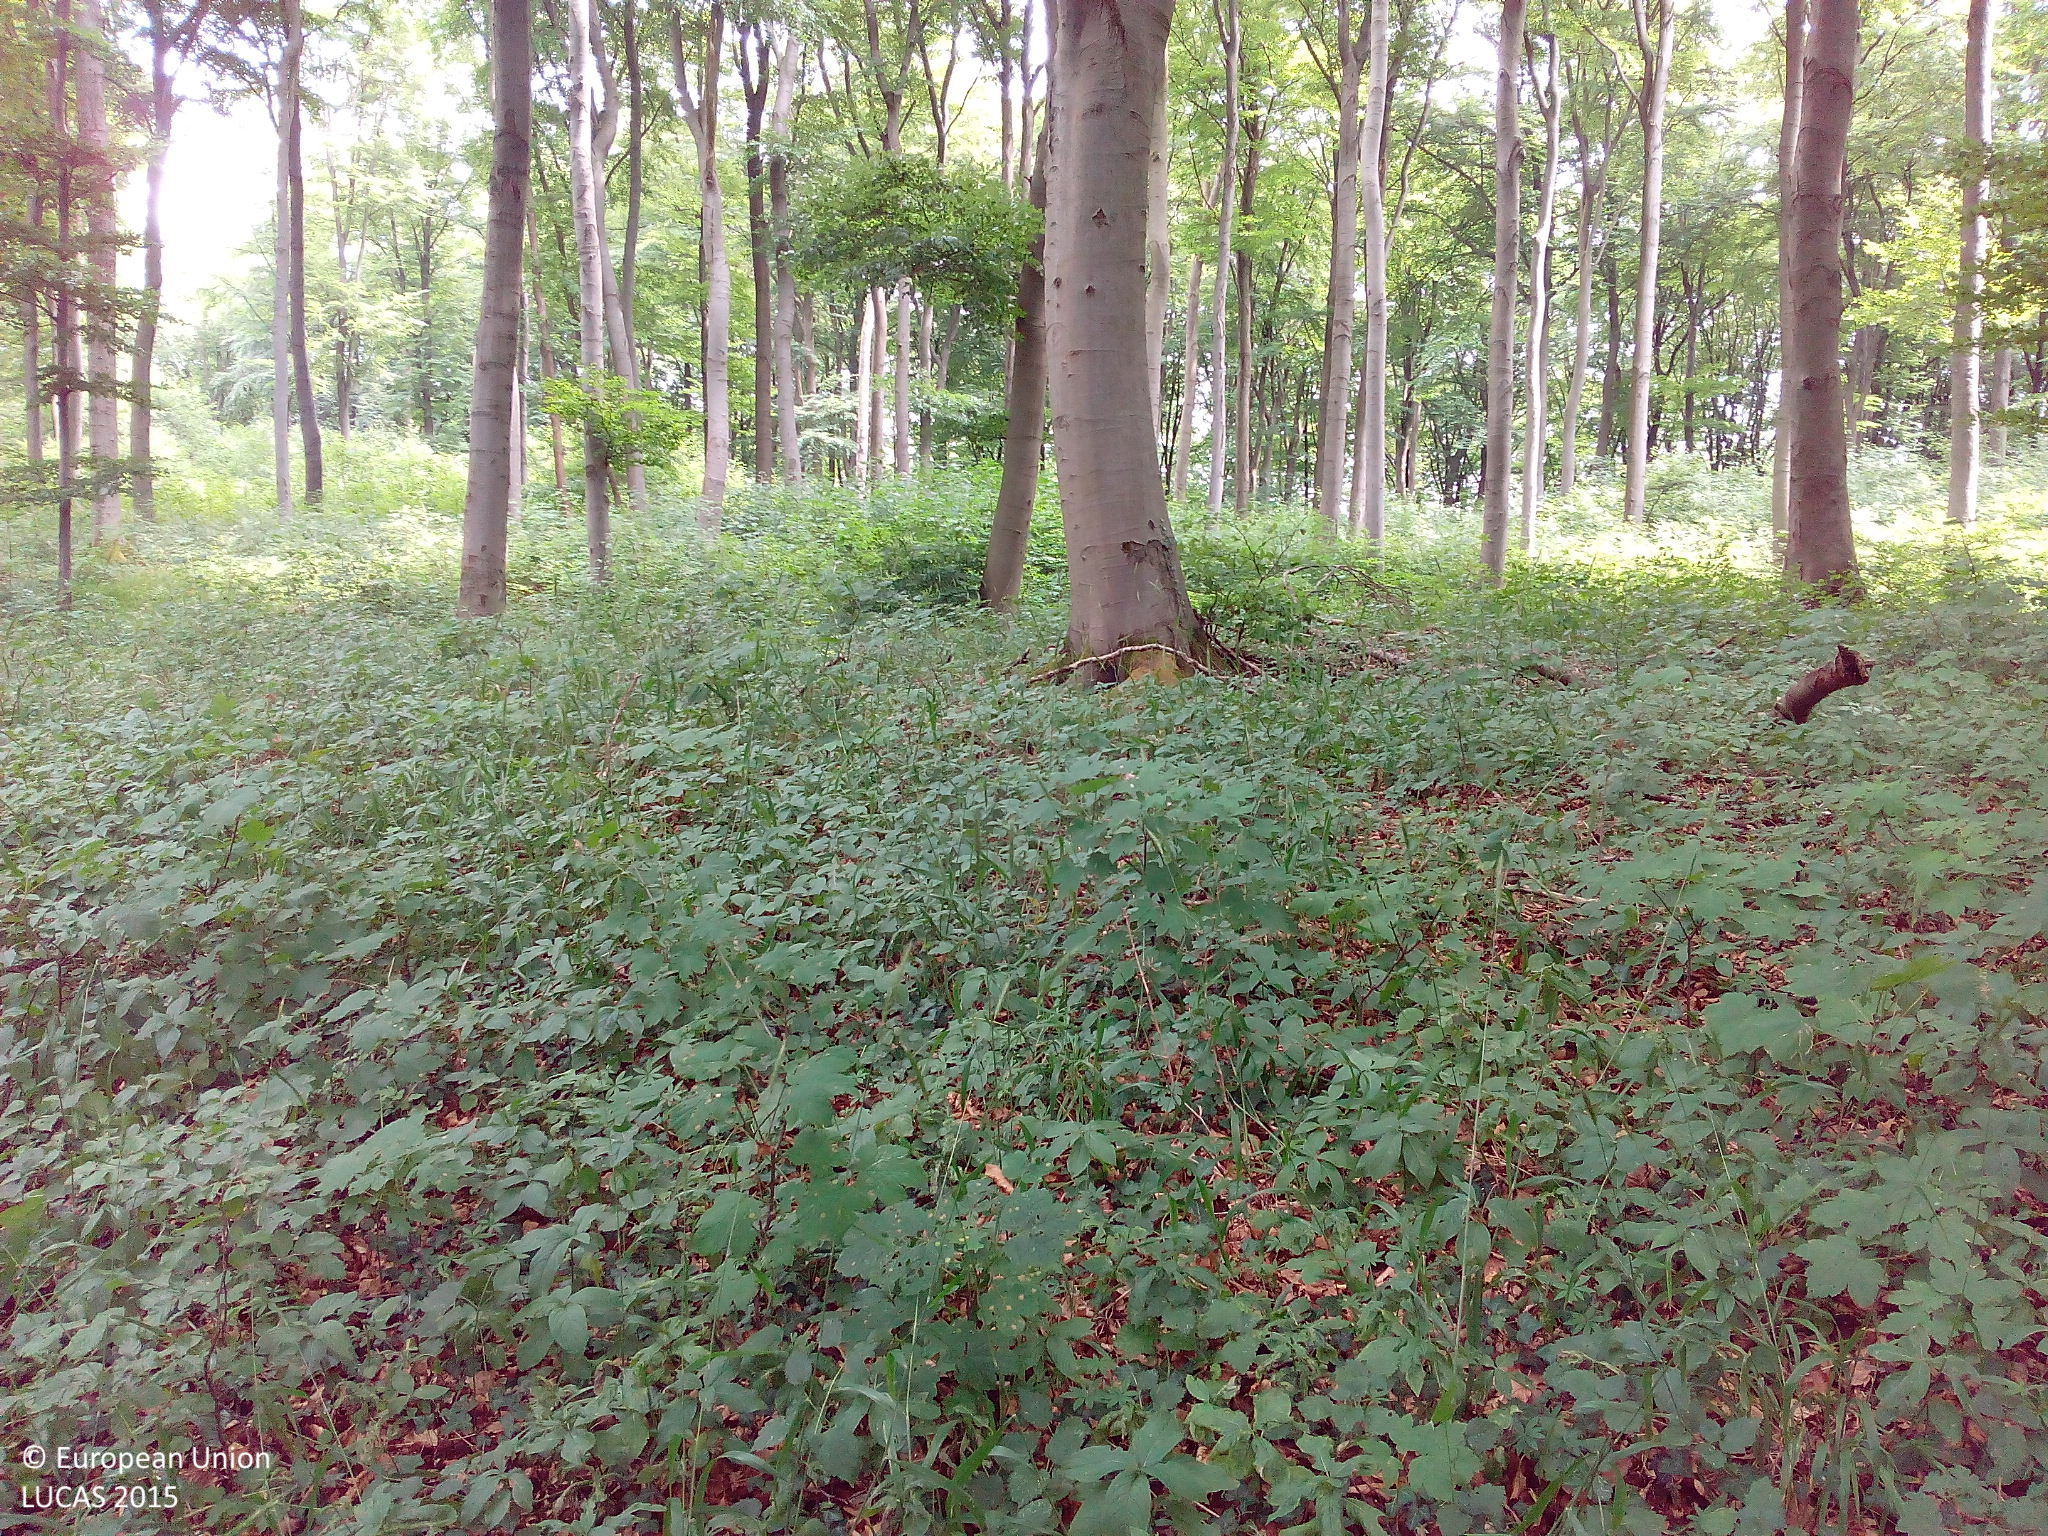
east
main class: Woodland
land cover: Broadleaved woodland
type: beech forest
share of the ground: > 75 %
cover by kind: broadleaved forest trees 90 %, herbaceous plants 10 %
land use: Forestry
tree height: > 5 m
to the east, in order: Broadleaved woodland; Tracks; Broadleaved woodland; Tracks; Broadleaved woodland; Other mixed woodland
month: July
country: DE
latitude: 50.8314
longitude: 9.8723
